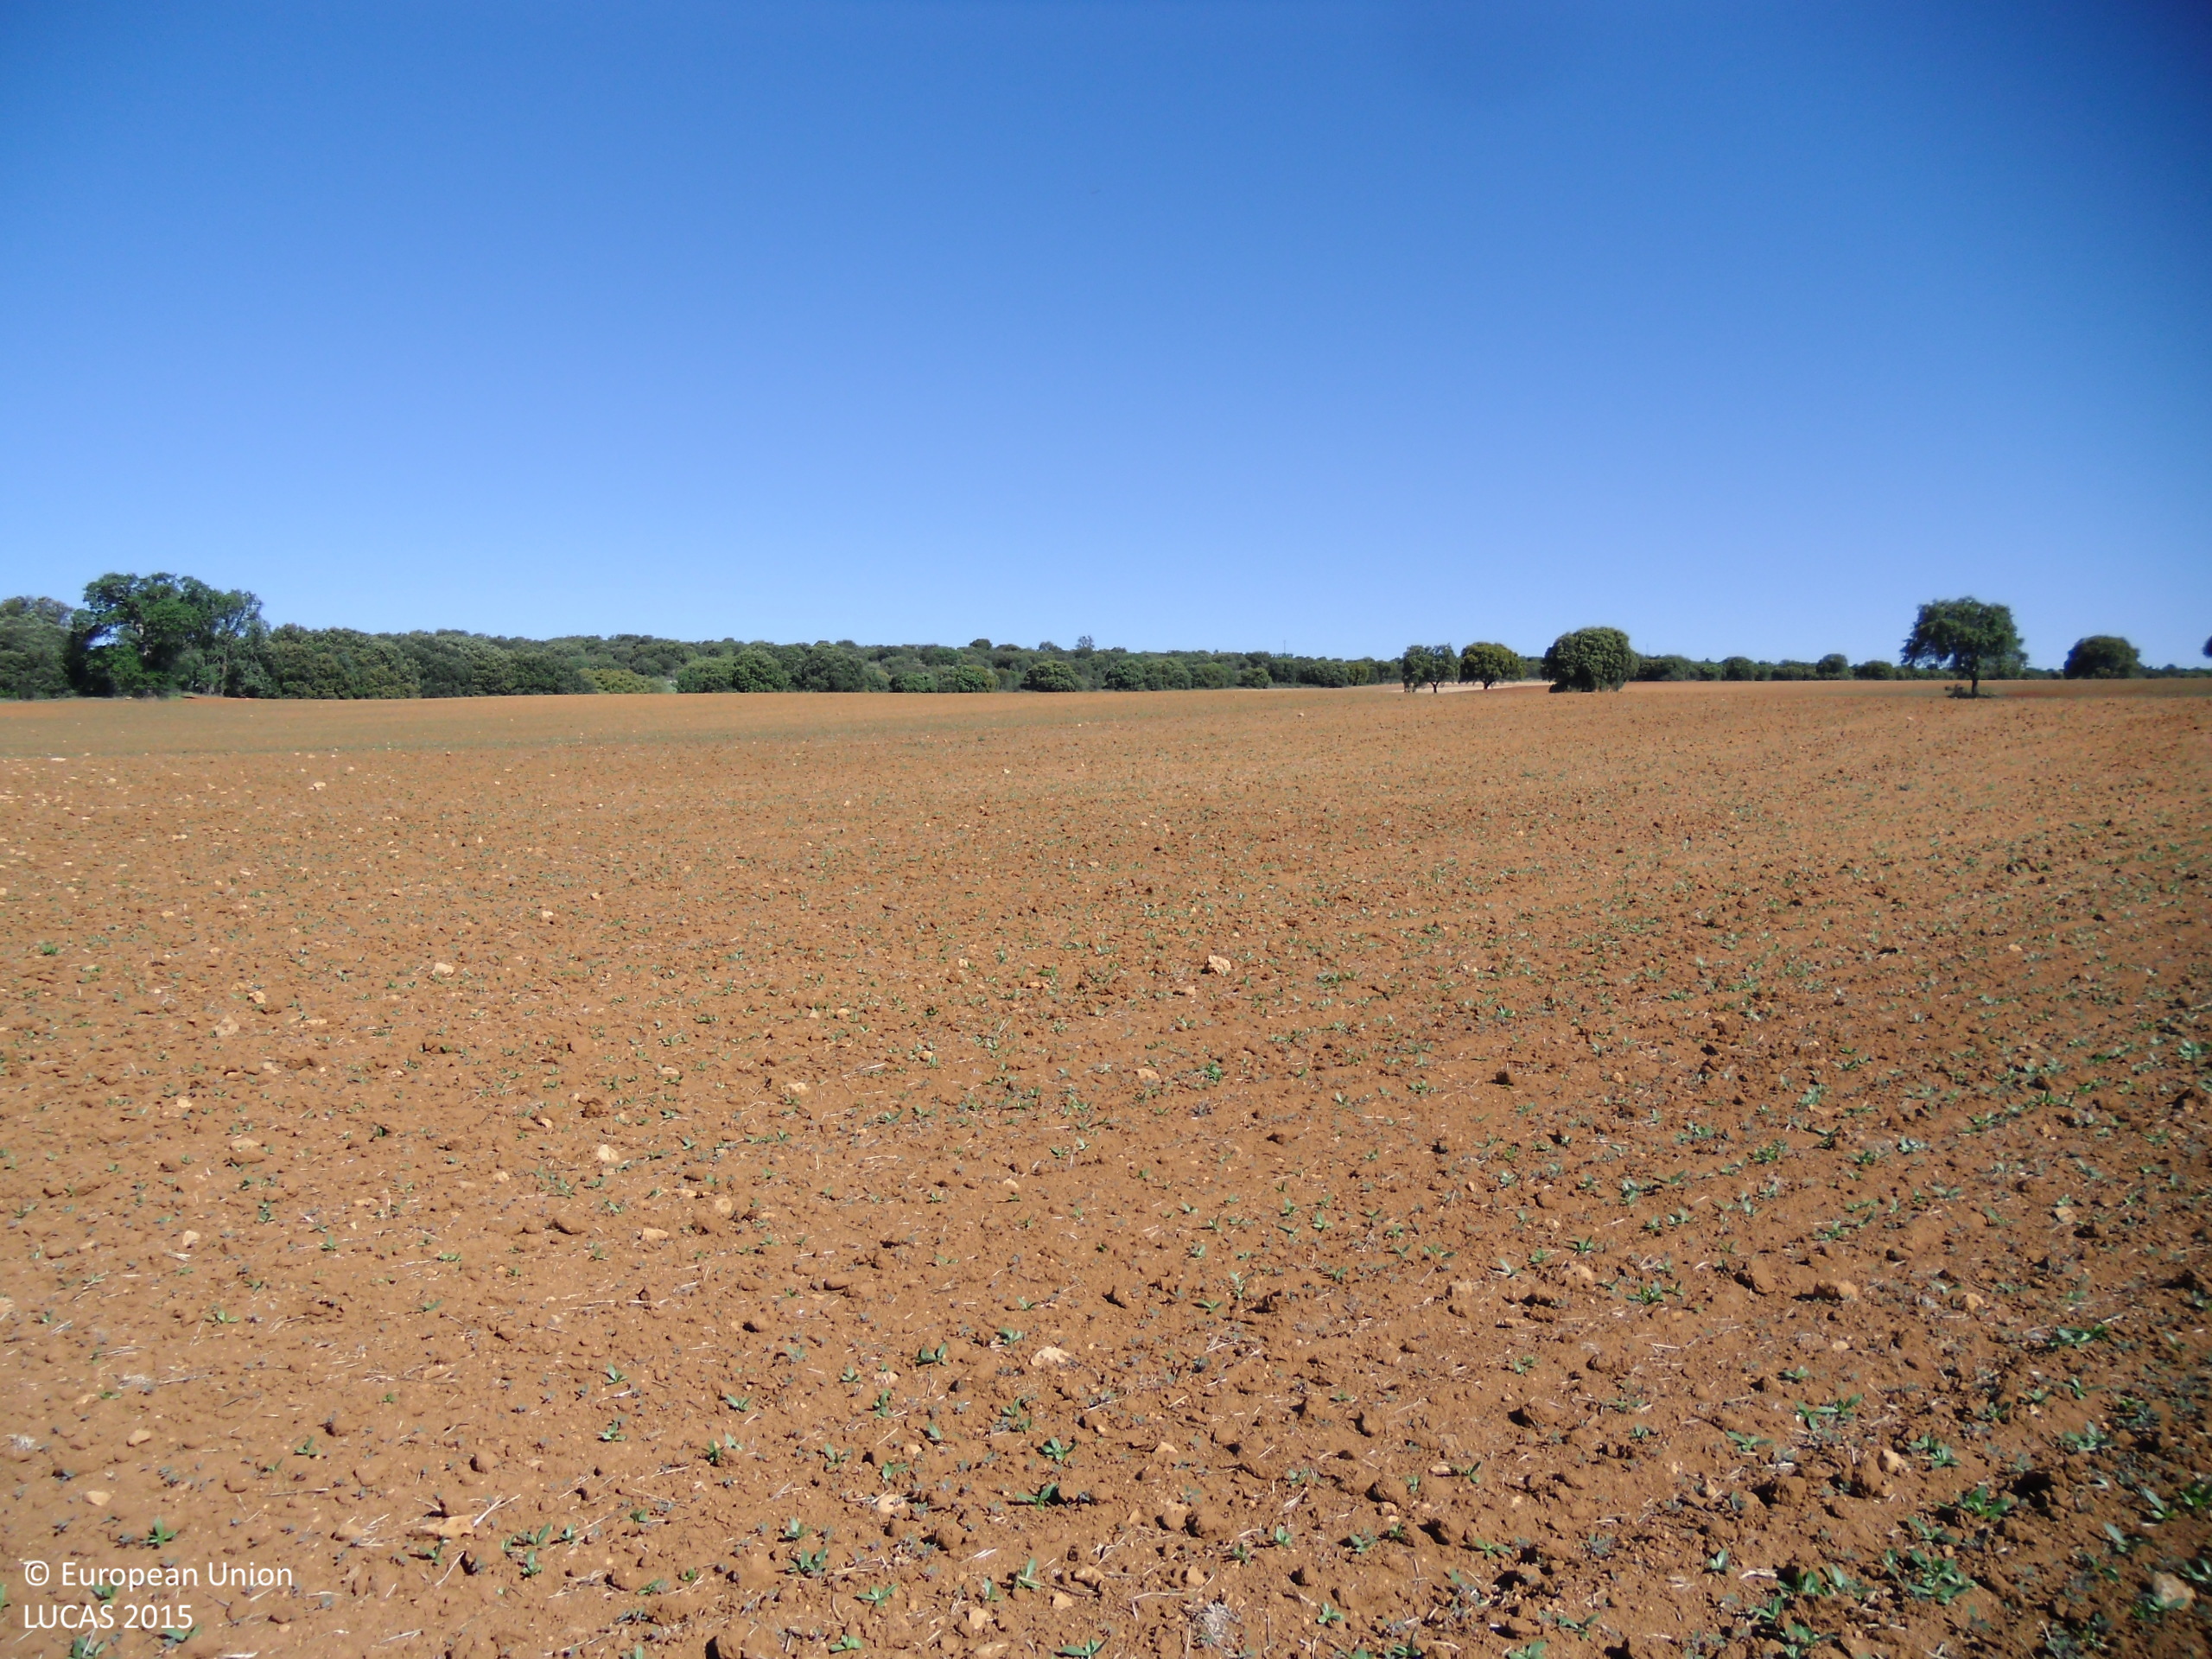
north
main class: Cropland
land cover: Soya
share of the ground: < 10 %
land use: Agriculture (excluding fallow land and kitchen gardens)
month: May
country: ES
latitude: 40.2031
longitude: -2.8654
